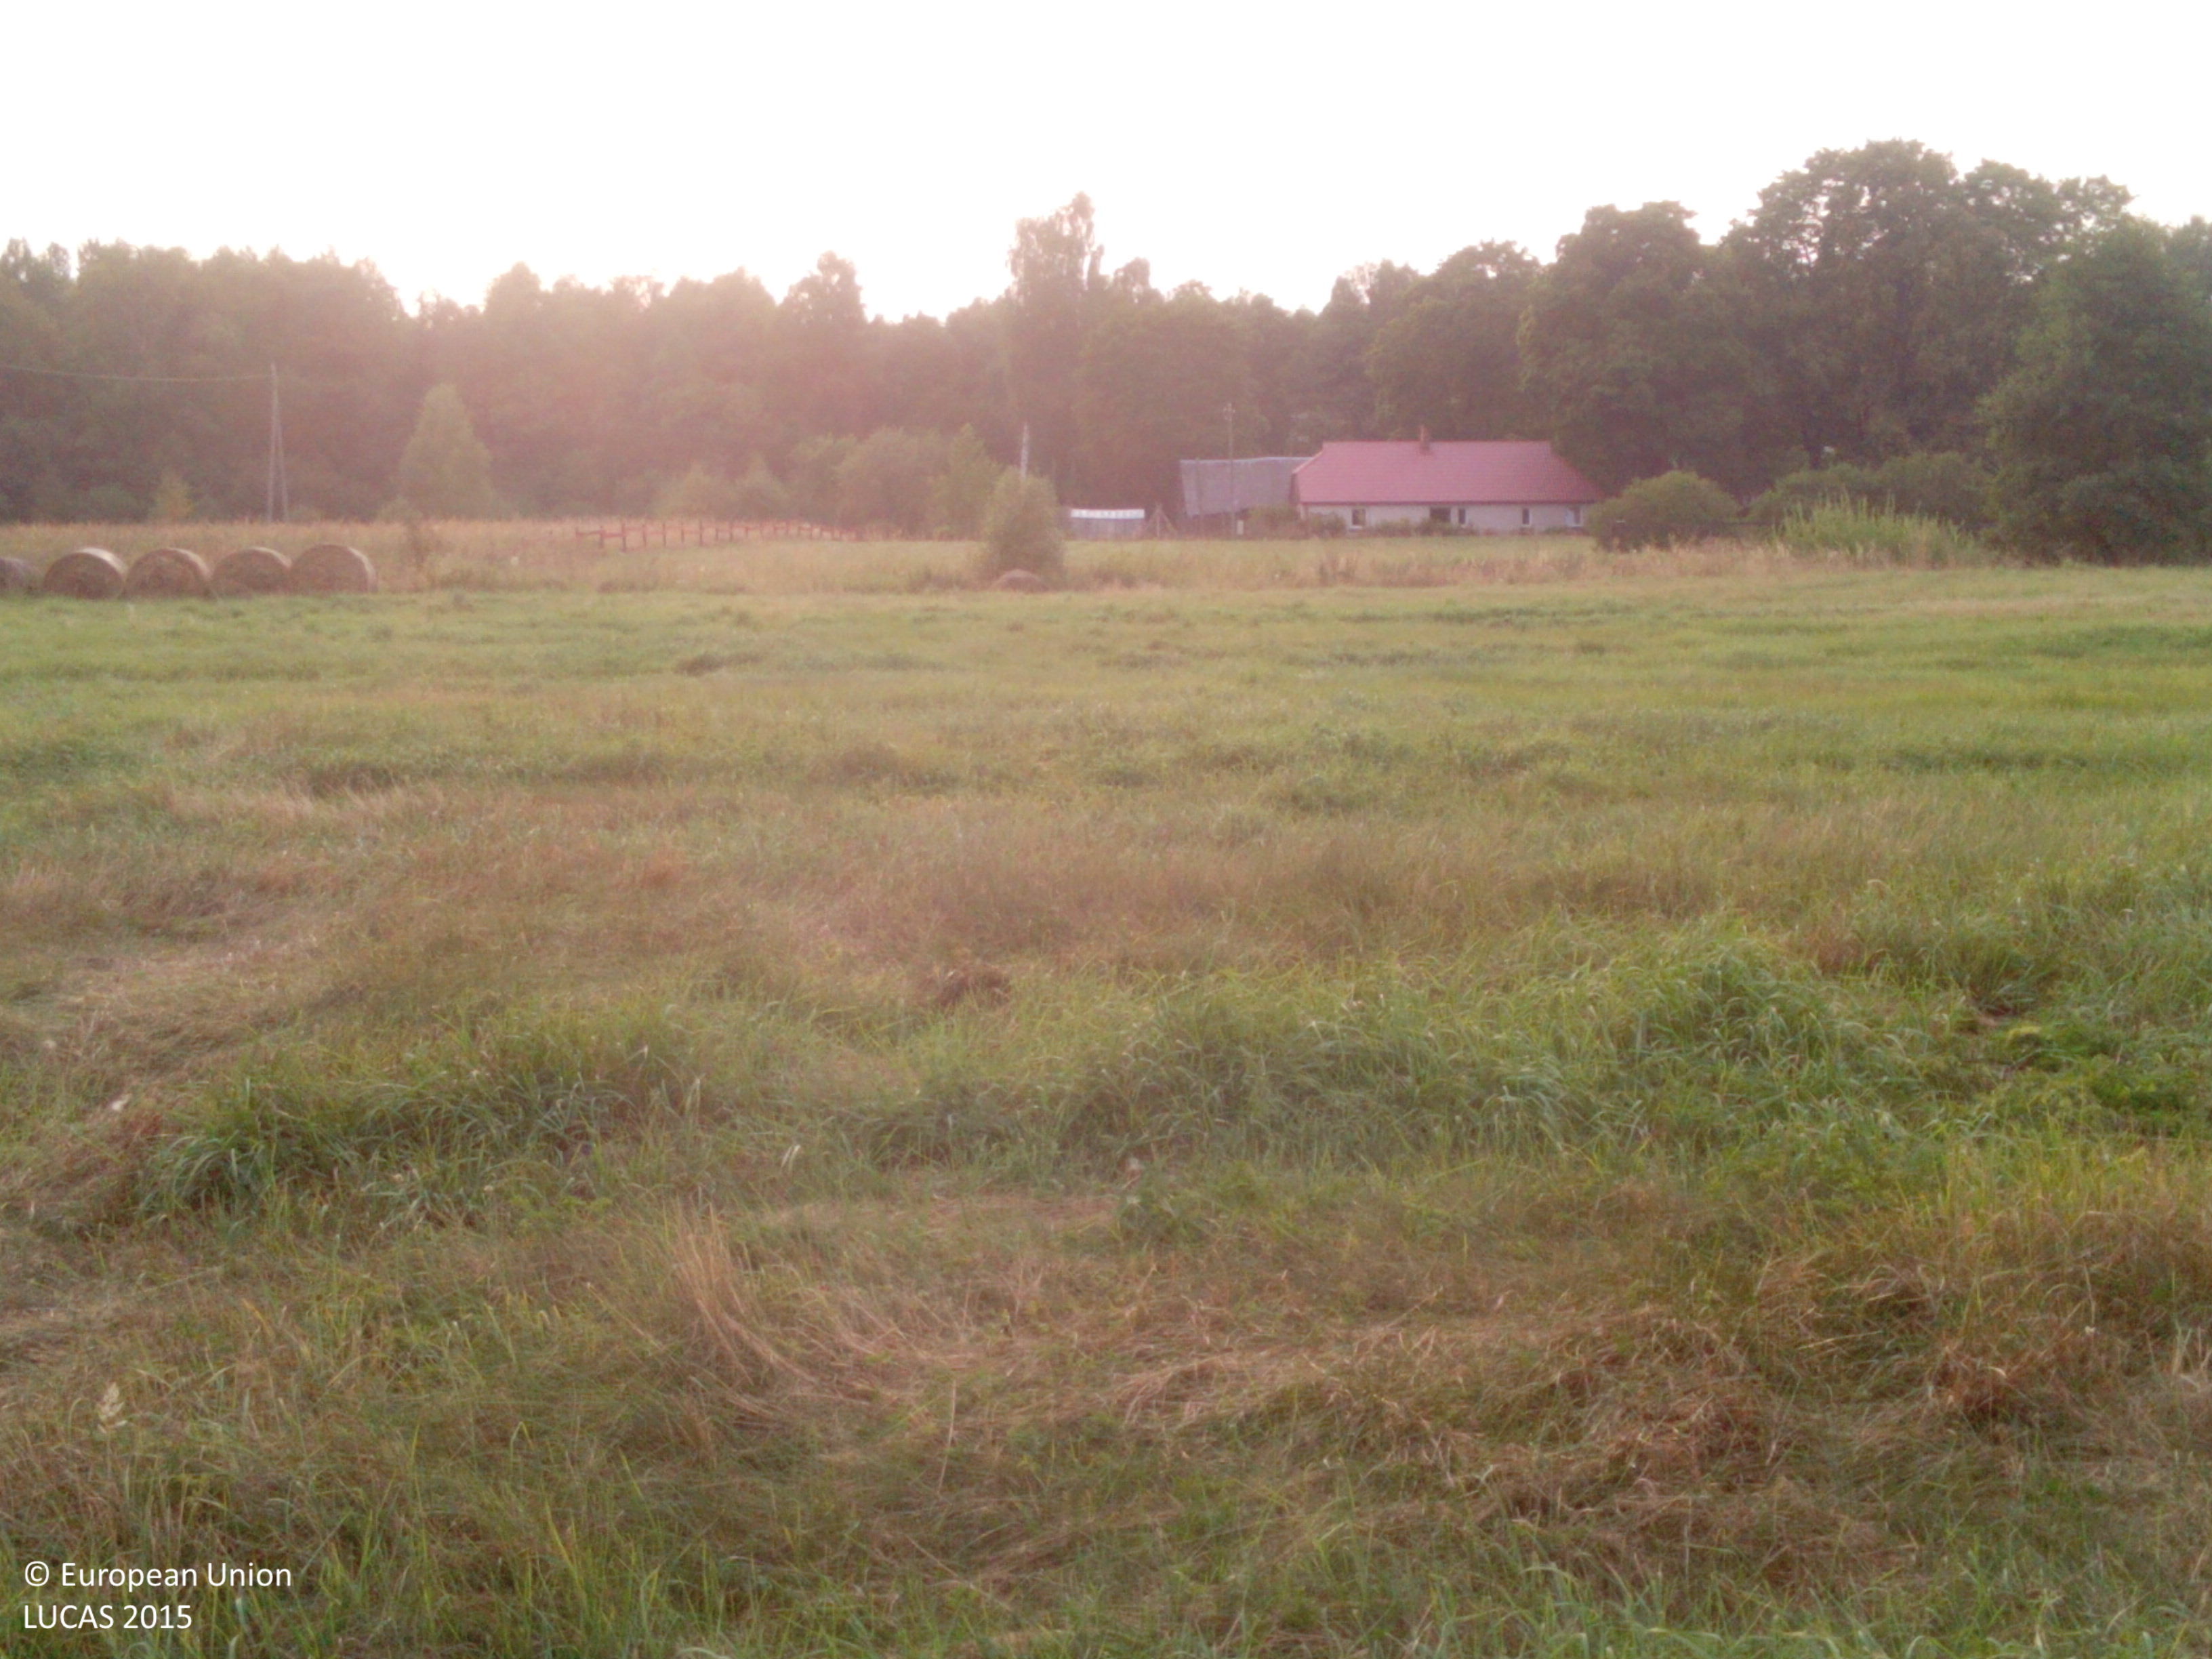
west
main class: Grassland
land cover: Grassland without tree/shrub cover
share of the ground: > 75 %
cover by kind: herbaceous plants 100 %
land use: Agriculture (excluding fallow land and kitchen gardens)
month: August
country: LV
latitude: 56.1355
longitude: 21.1581
